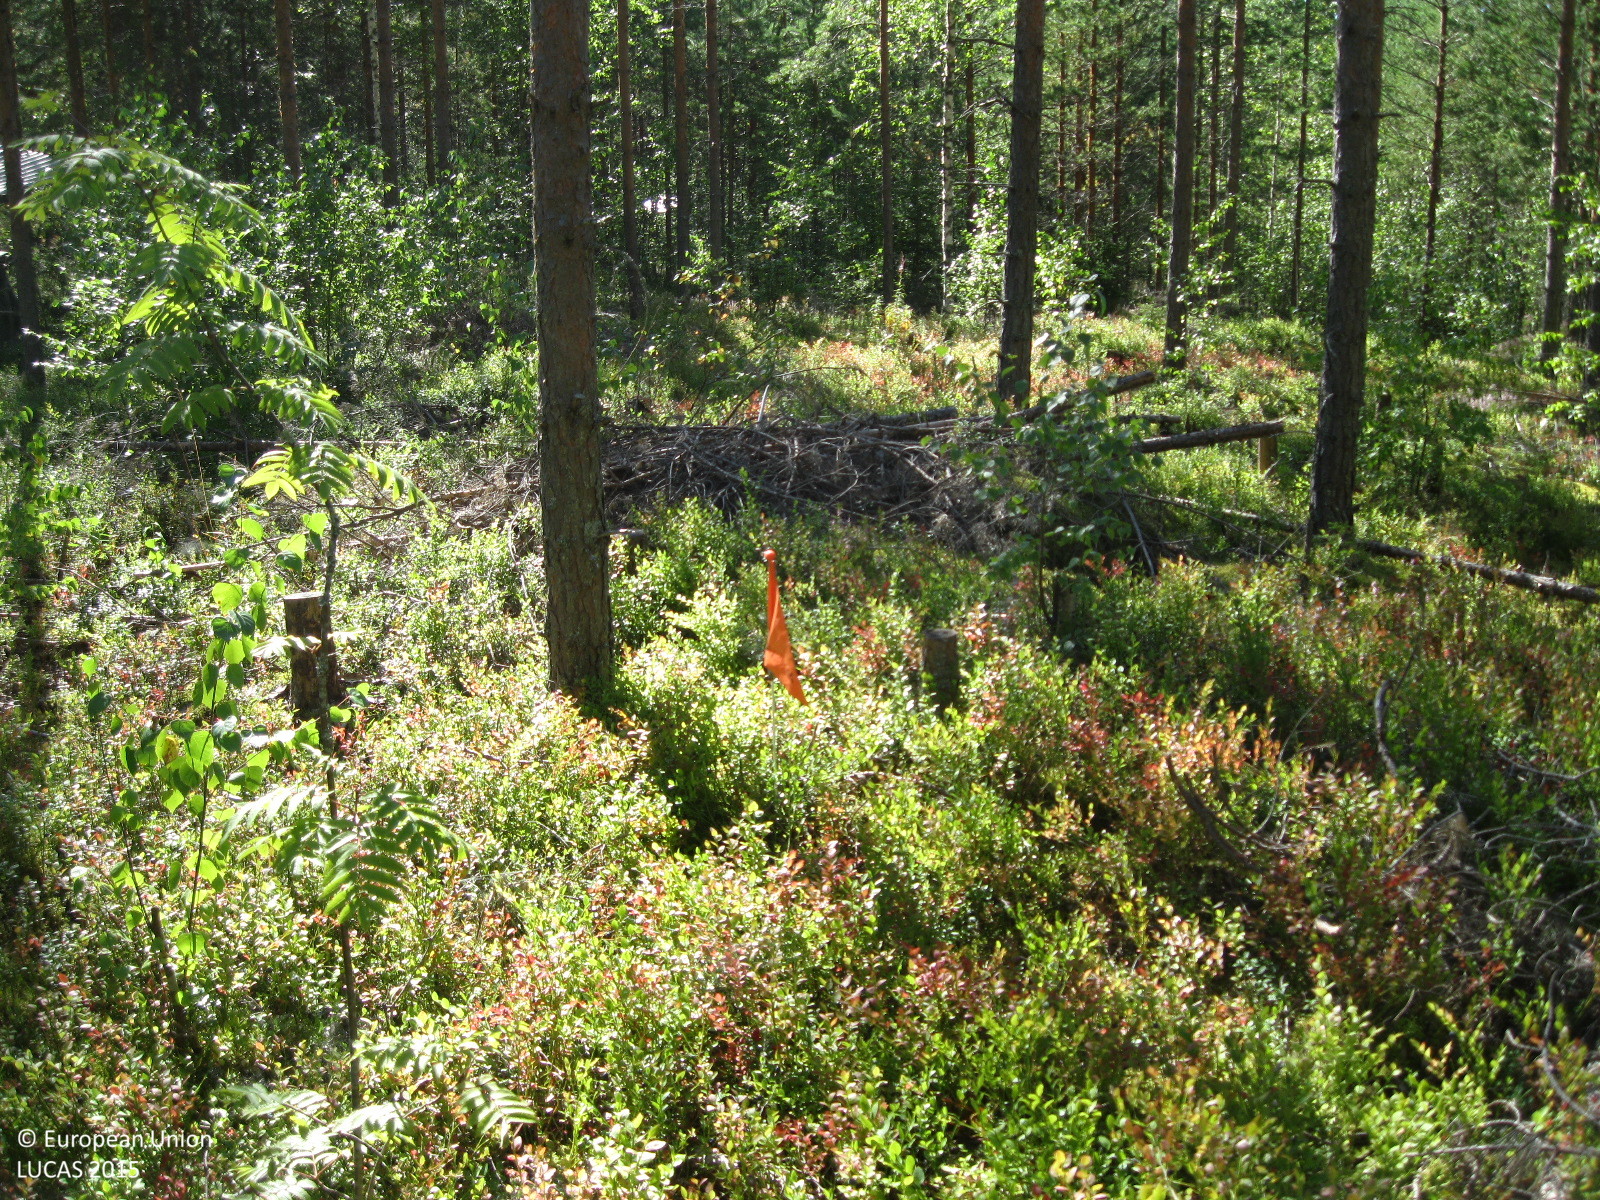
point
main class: Woodland
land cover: Pine dominated coniferous woodland
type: boreal forest
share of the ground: 25 - 50 %
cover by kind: coniferous forest trees 45 %, shrubs 40 %, lichens and mosses 10 %, broadleaved forest trees 5 %
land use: Forestry
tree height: > 5 m
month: August
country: FI
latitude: 61.4479
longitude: 25.3665
